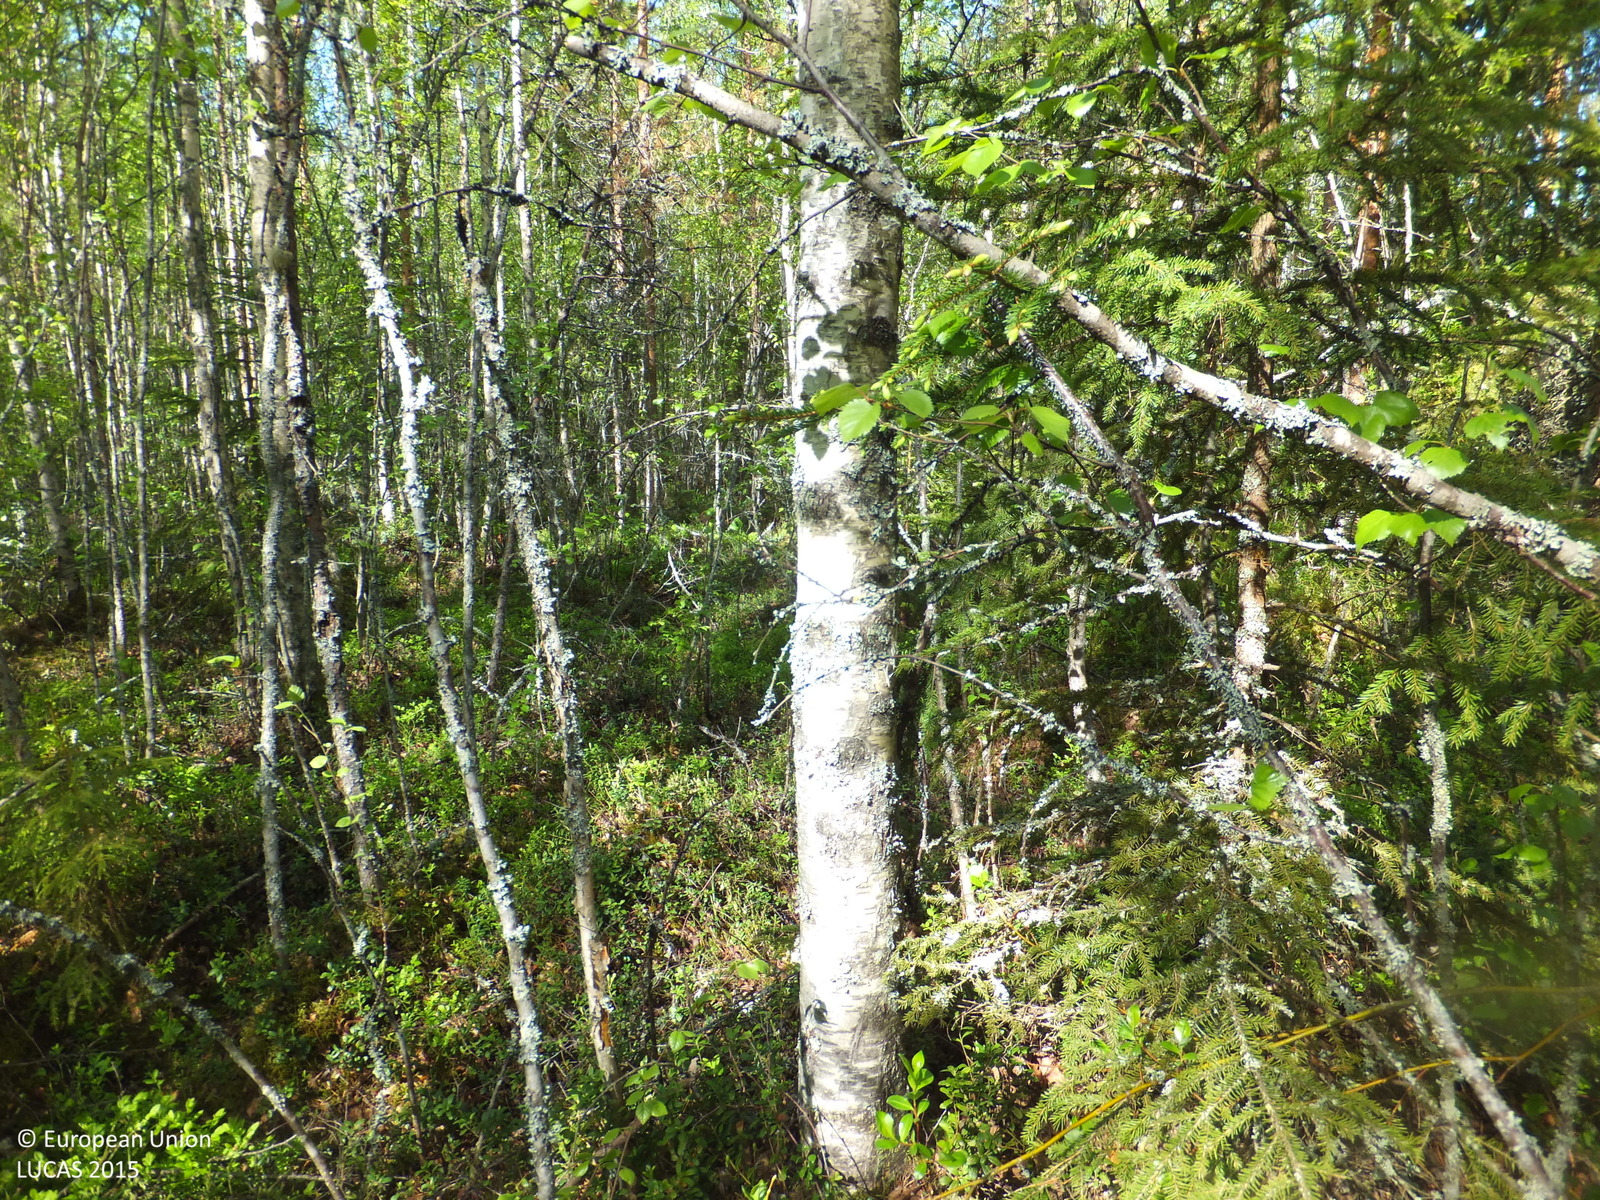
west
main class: Woodland
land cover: Spruce dominated mixed woodland
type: boreal forest
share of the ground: > 75 %
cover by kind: broadleaved forest trees 60 %, coniferous forest trees 30 %, shrubs 10 %
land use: Forestry
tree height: > 5 m
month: June
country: FI
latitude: 63.5915
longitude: 22.9296
